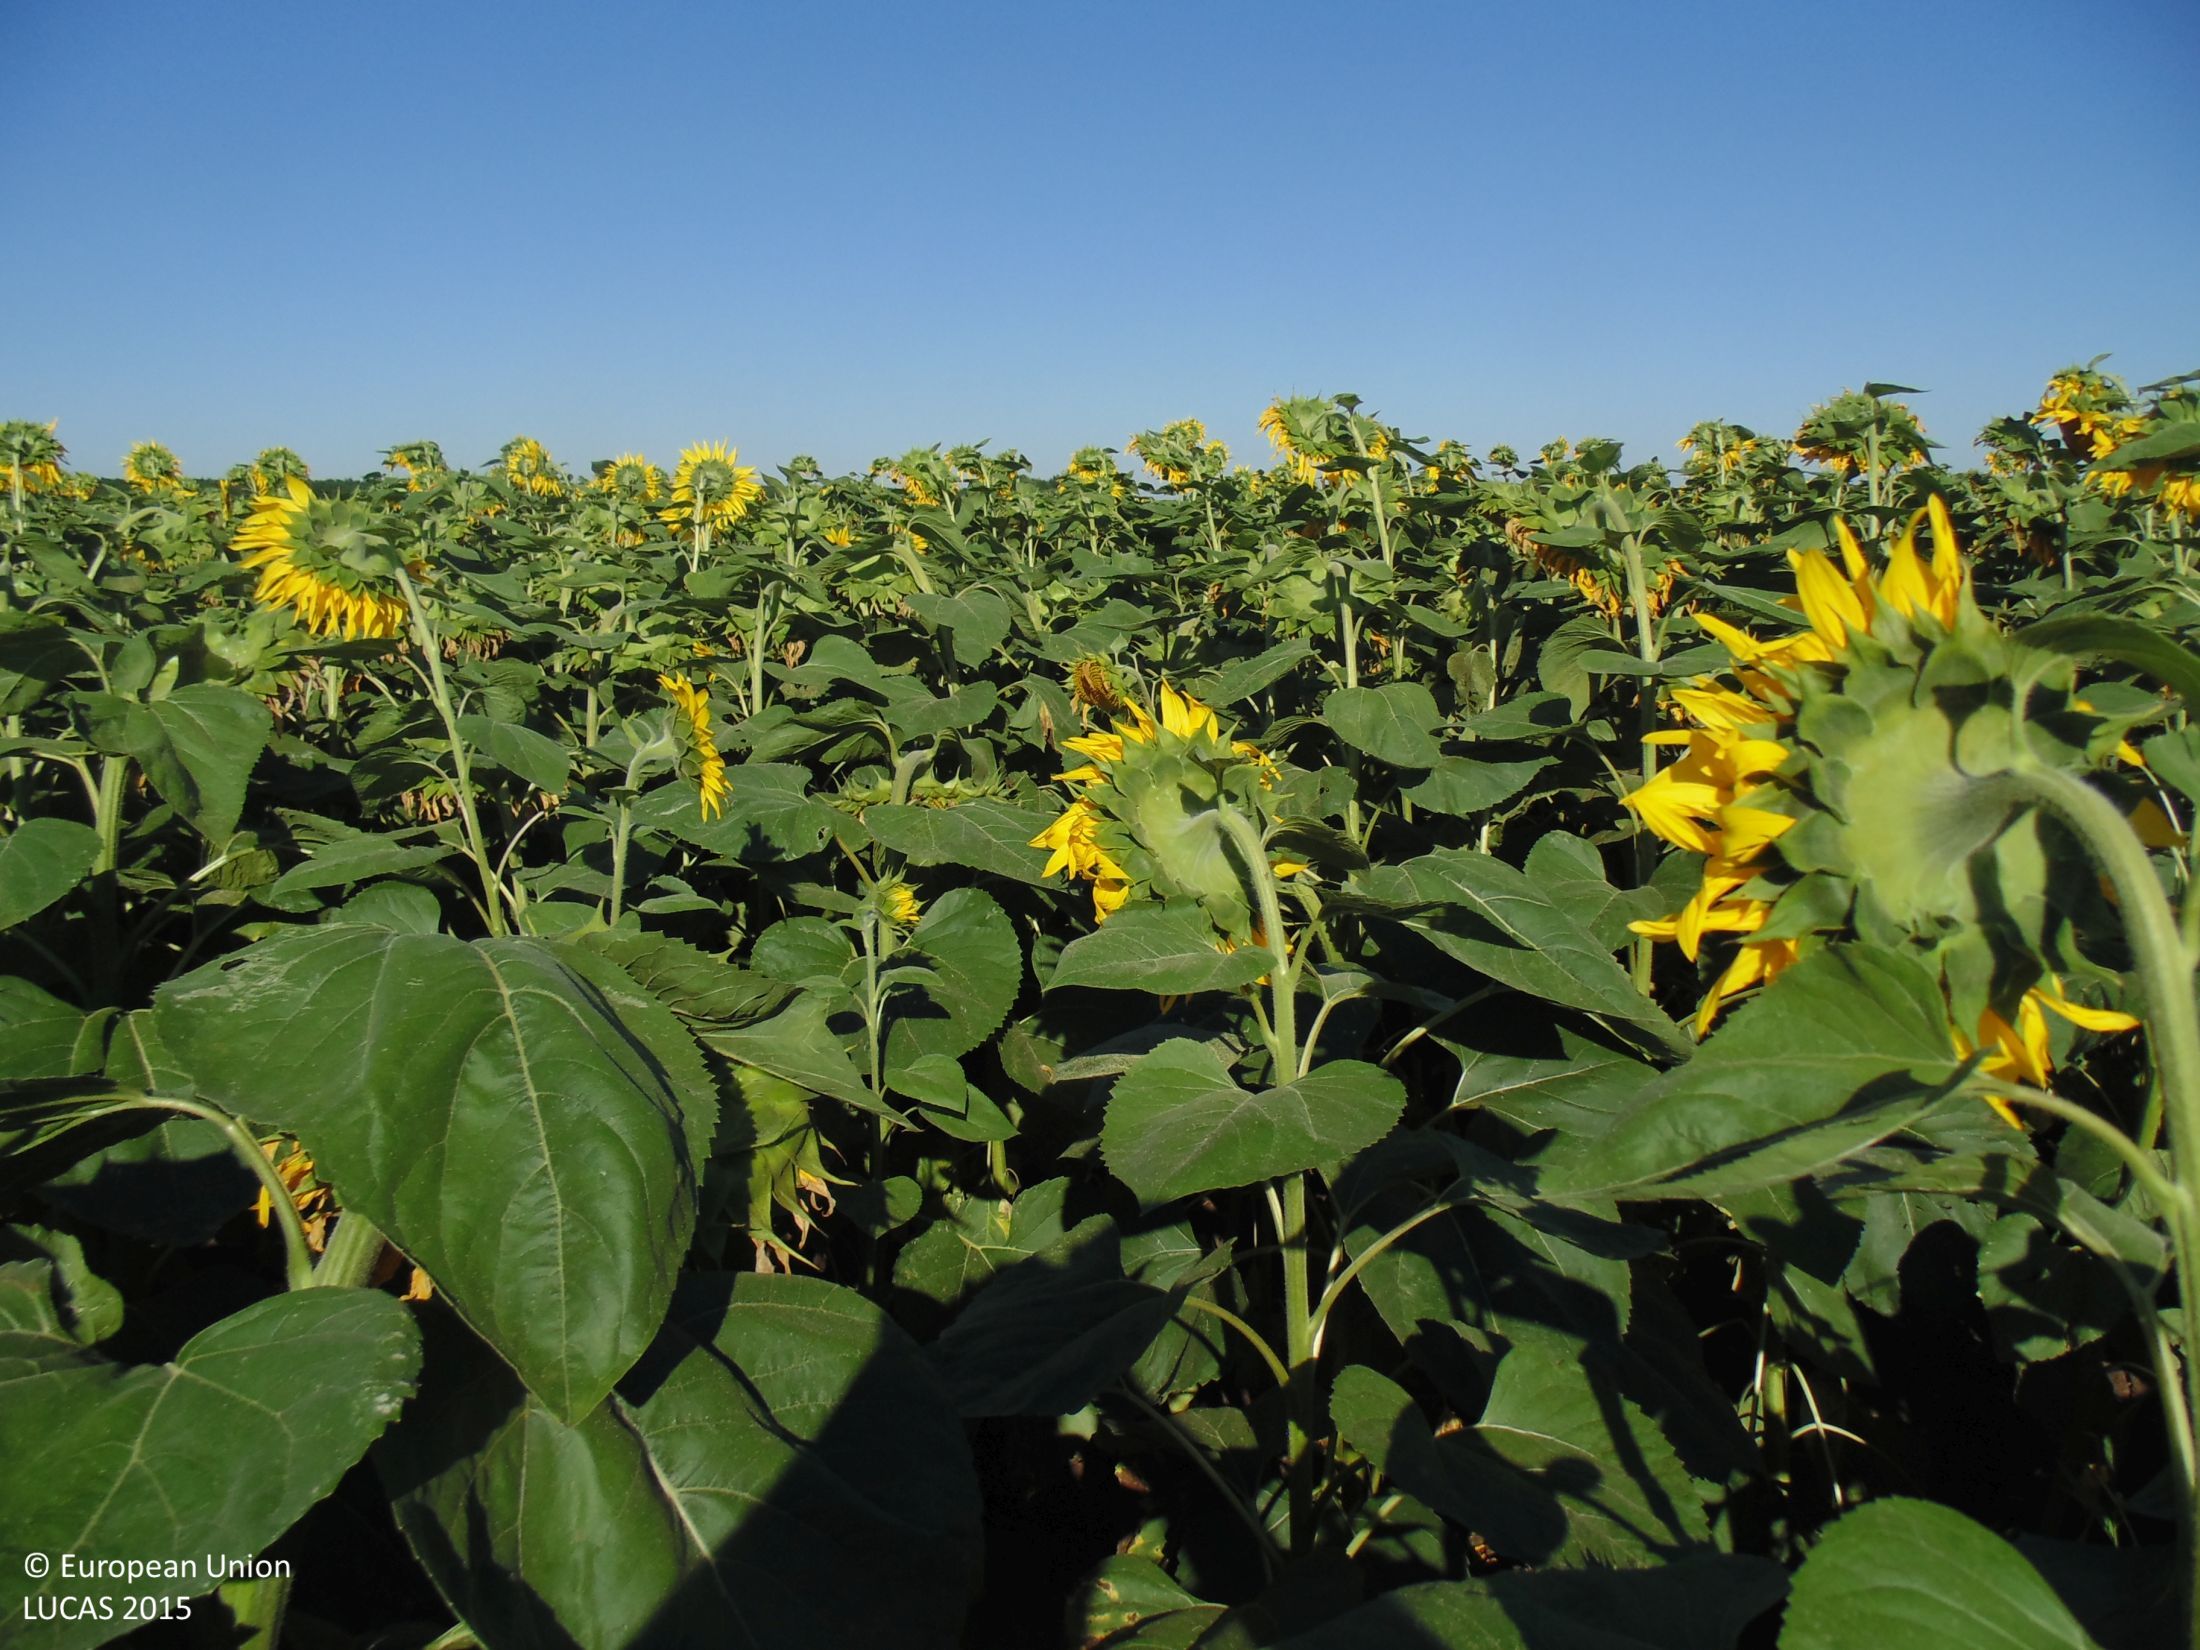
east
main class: Cropland
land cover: Sunflower
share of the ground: > 75 %
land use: Agriculture (excluding fallow land and kitchen gardens)
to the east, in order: Sunflower; Grass margins; Tracks; Common wheat
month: July
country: BG
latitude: 43.4520
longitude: 28.0528
